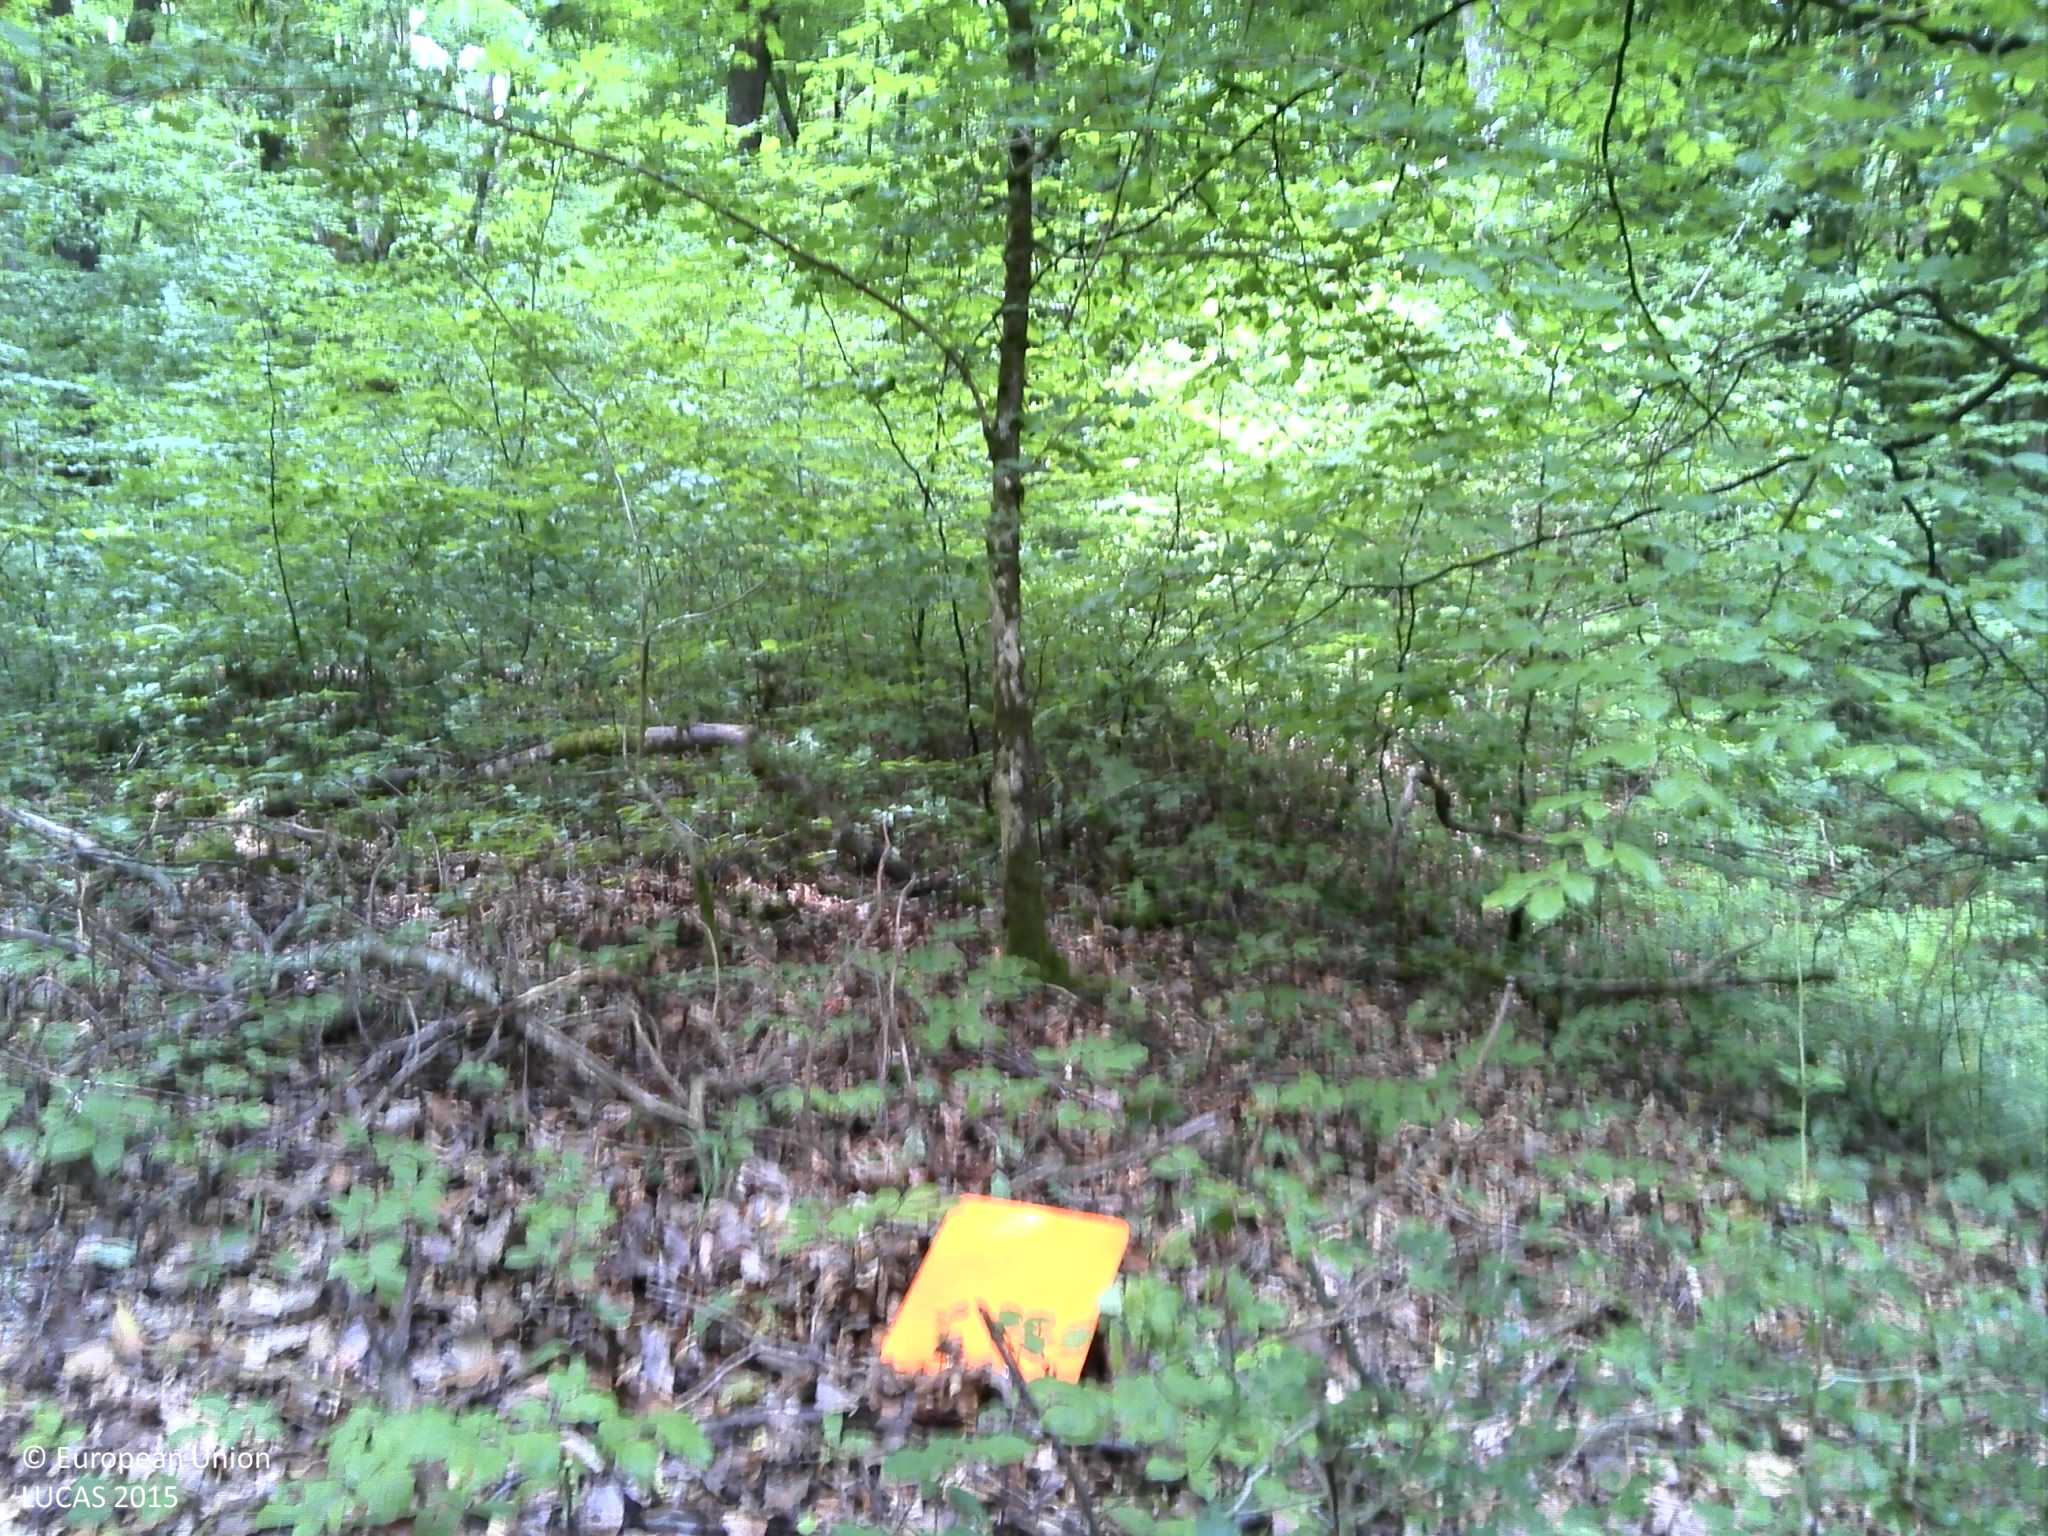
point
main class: Woodland
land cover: Broadleaved woodland
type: acidophilous oak and oak-birch forest
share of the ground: > 75 %
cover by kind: broadleaved forest trees 90 %, herbaceous plants 10 %
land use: Forestry
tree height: > 5 m
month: July
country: FR
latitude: 49.3023
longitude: 6.4930
